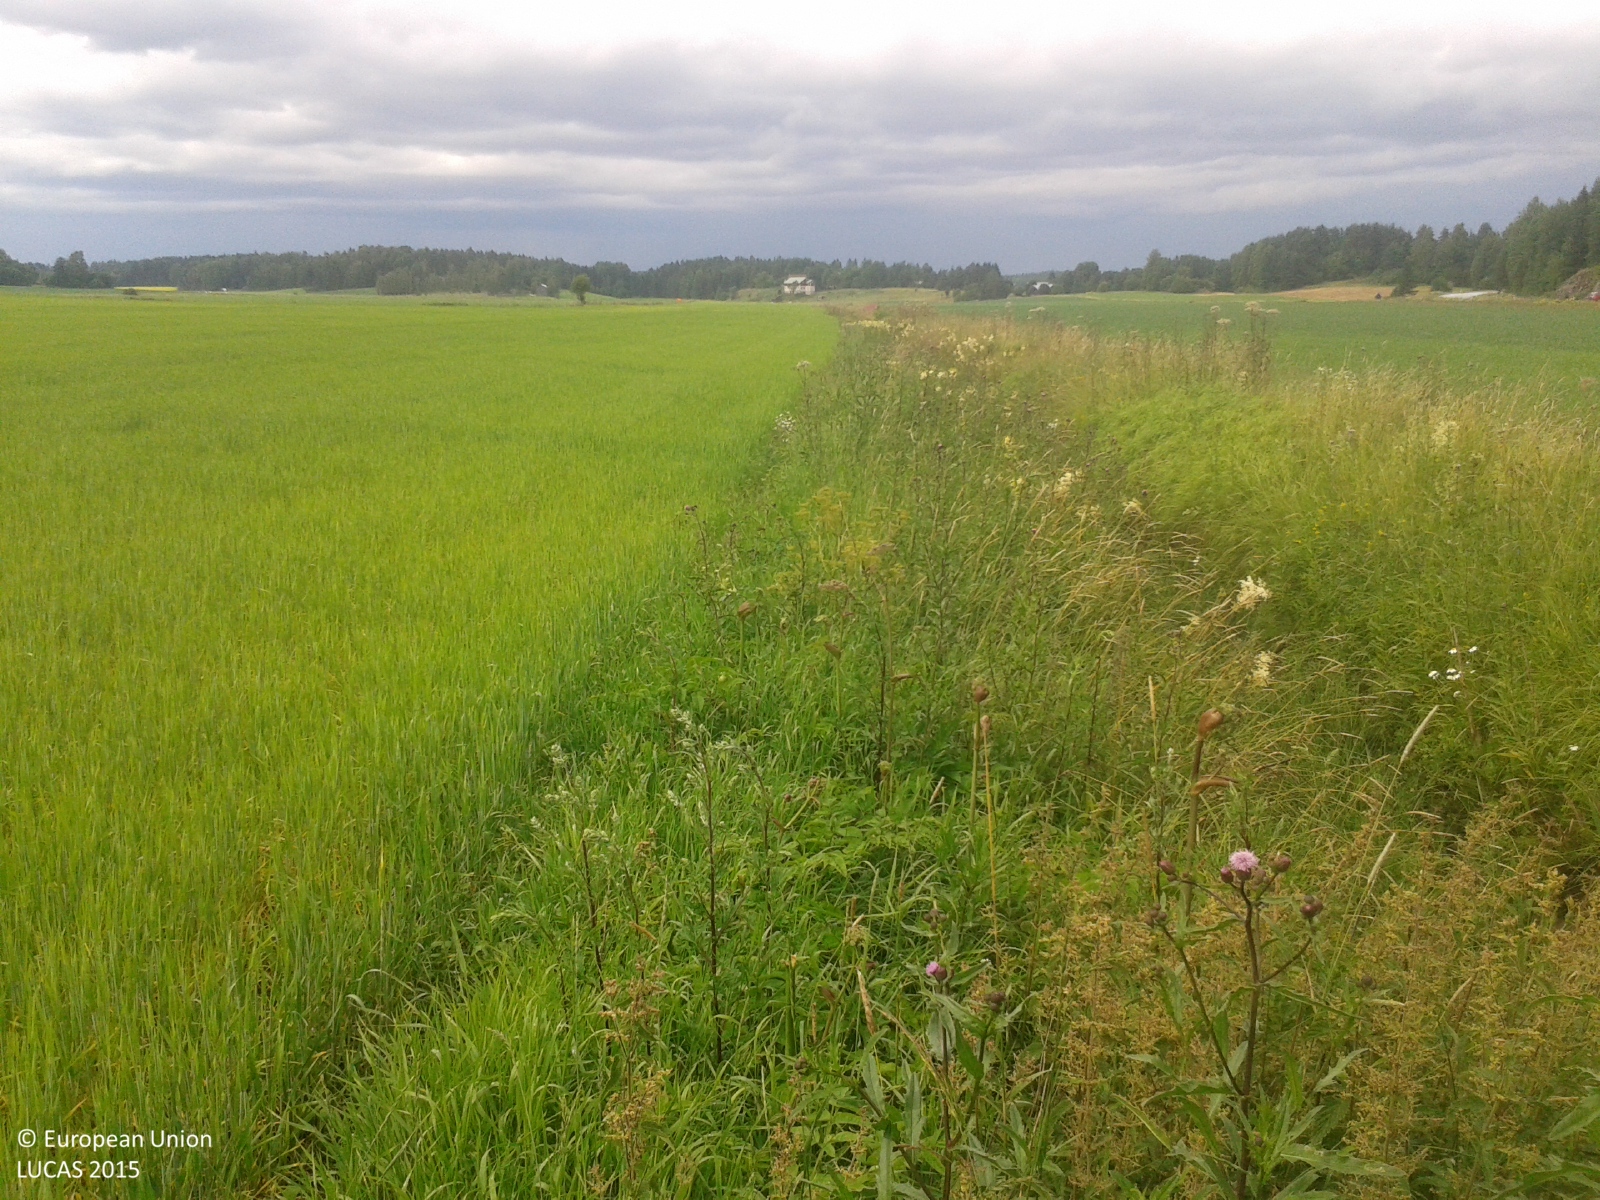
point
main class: Cropland
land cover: Barley
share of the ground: > 75 %
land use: Agriculture (excluding fallow land and kitchen gardens)
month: July
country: FI
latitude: 60.0865
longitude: 23.9585
